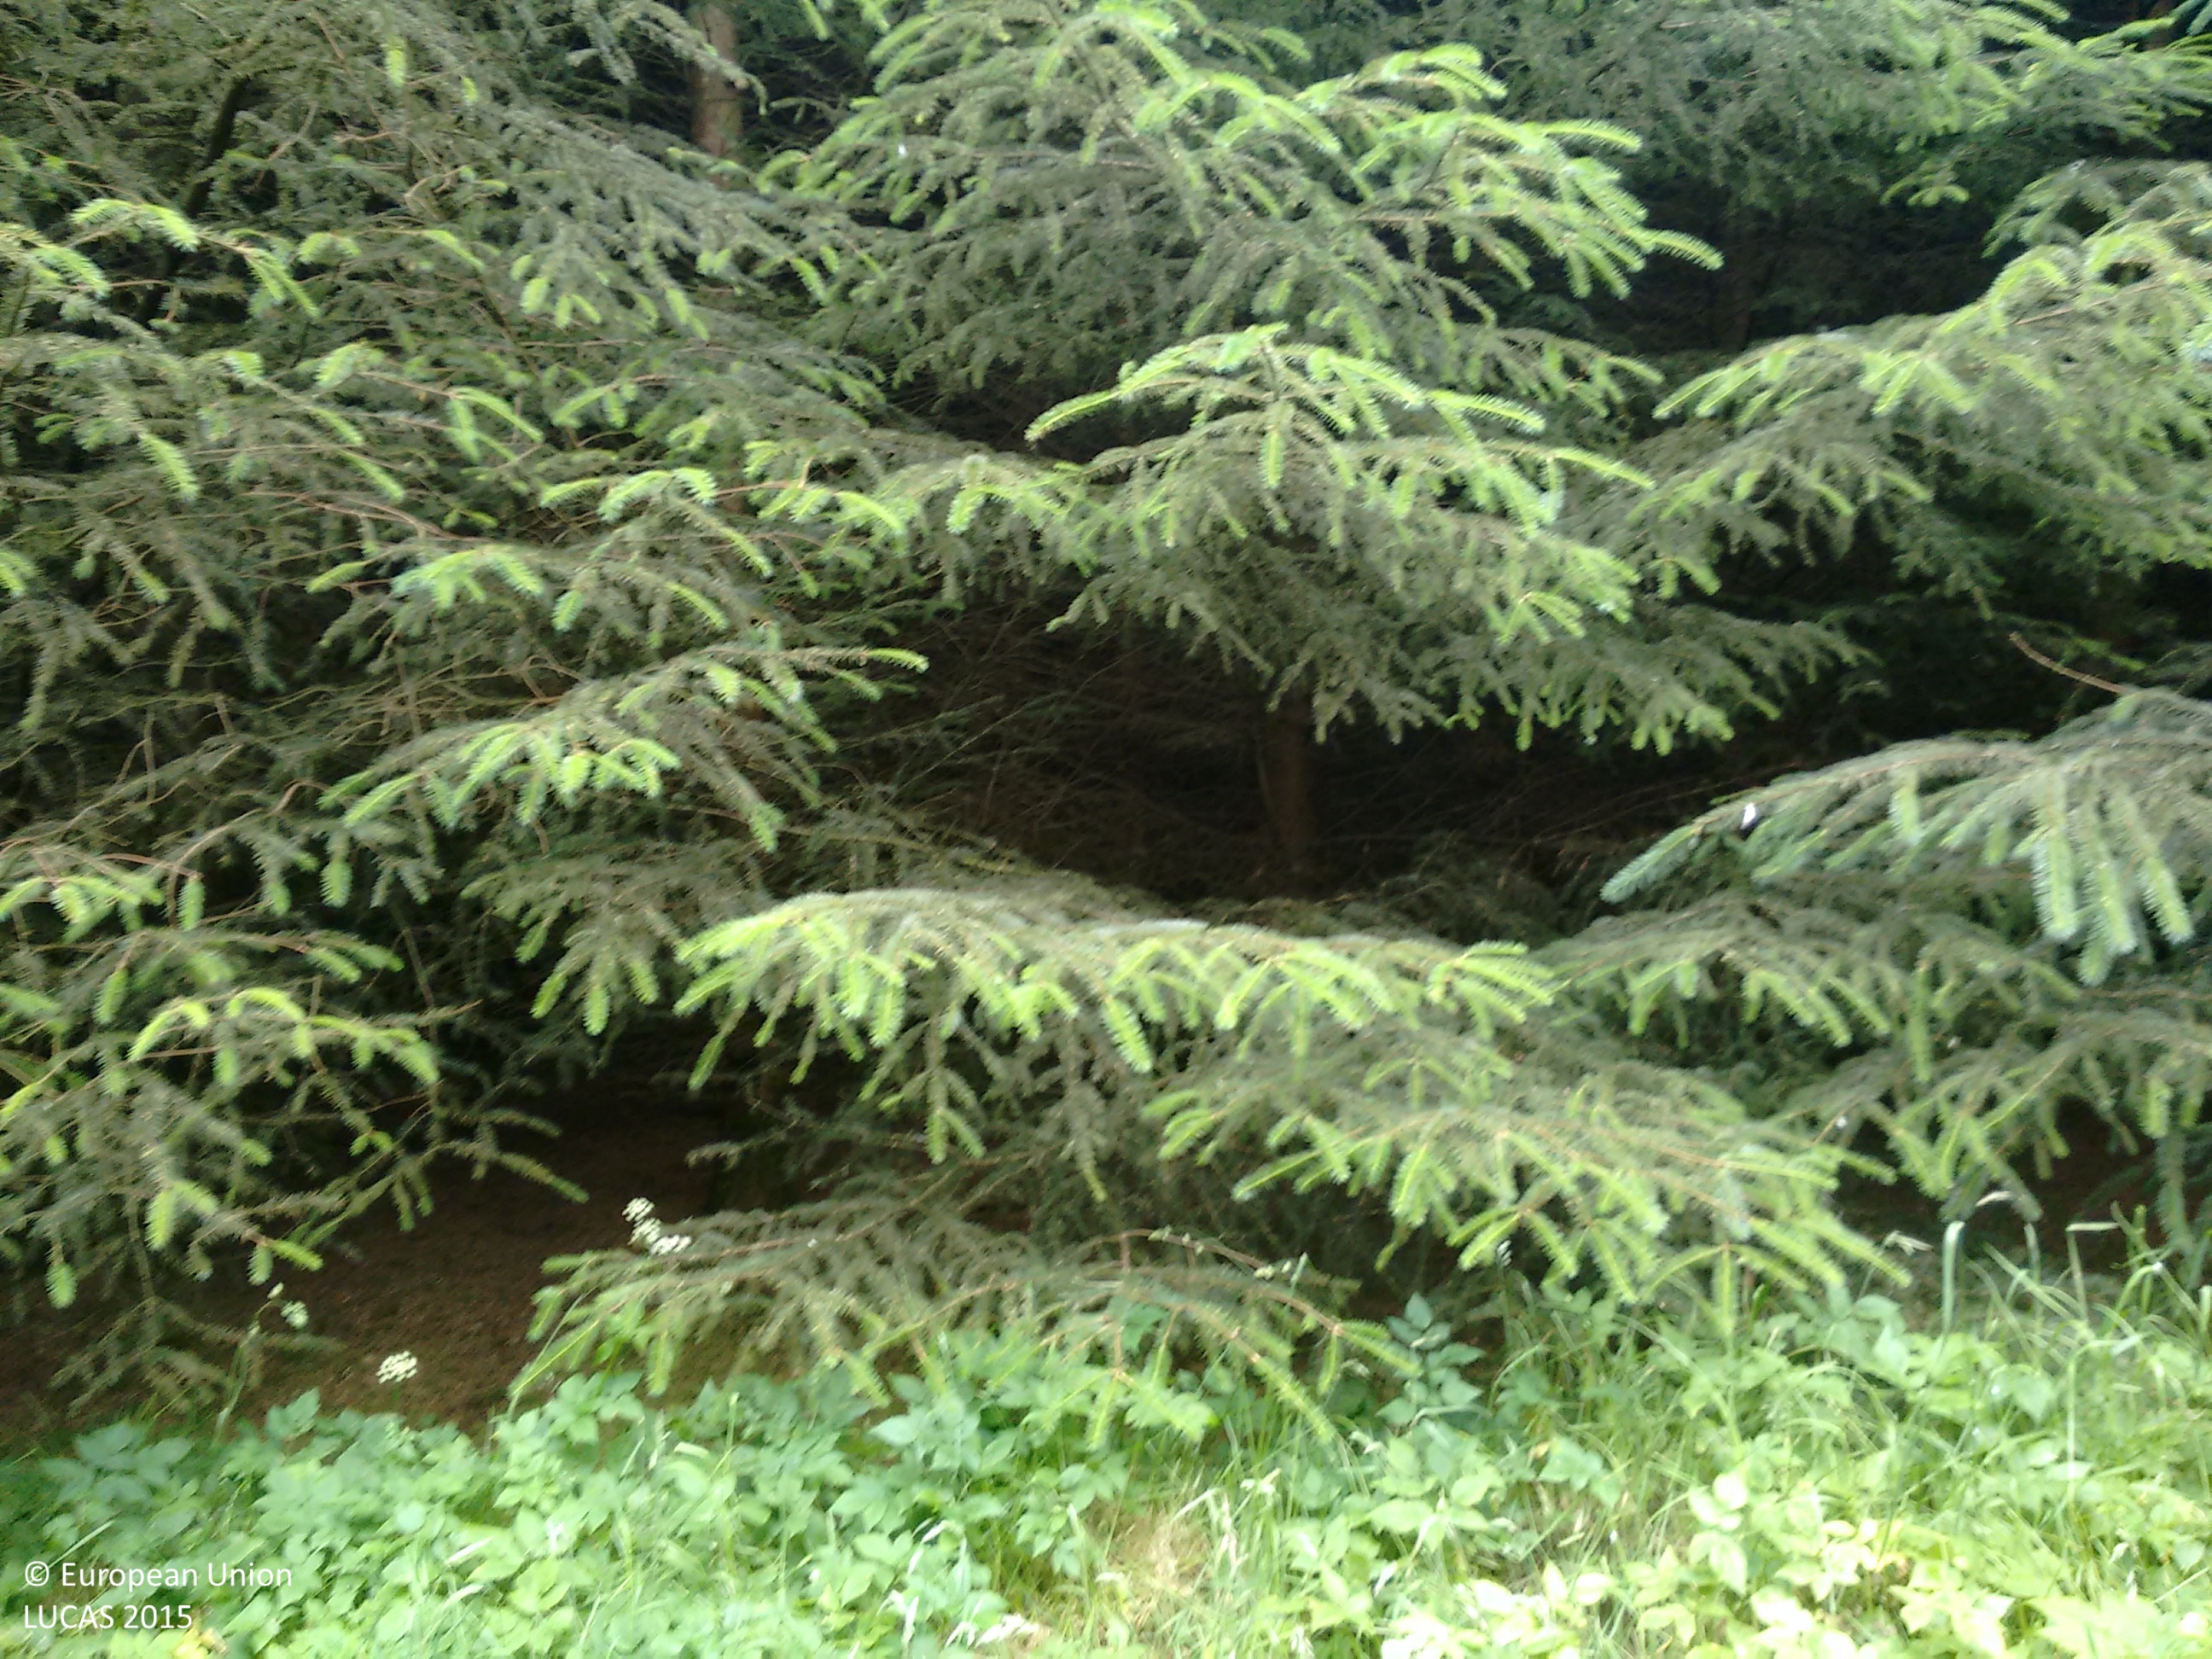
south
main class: Woodland
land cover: Spruce dominated coniferous woodland
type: exotic forest
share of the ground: > 75 %
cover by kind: coniferous forest trees 95 %, herbaceous plants 5 %
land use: Forestry
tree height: > 5 m
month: July
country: GB
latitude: 57.3923
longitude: -2.3465
